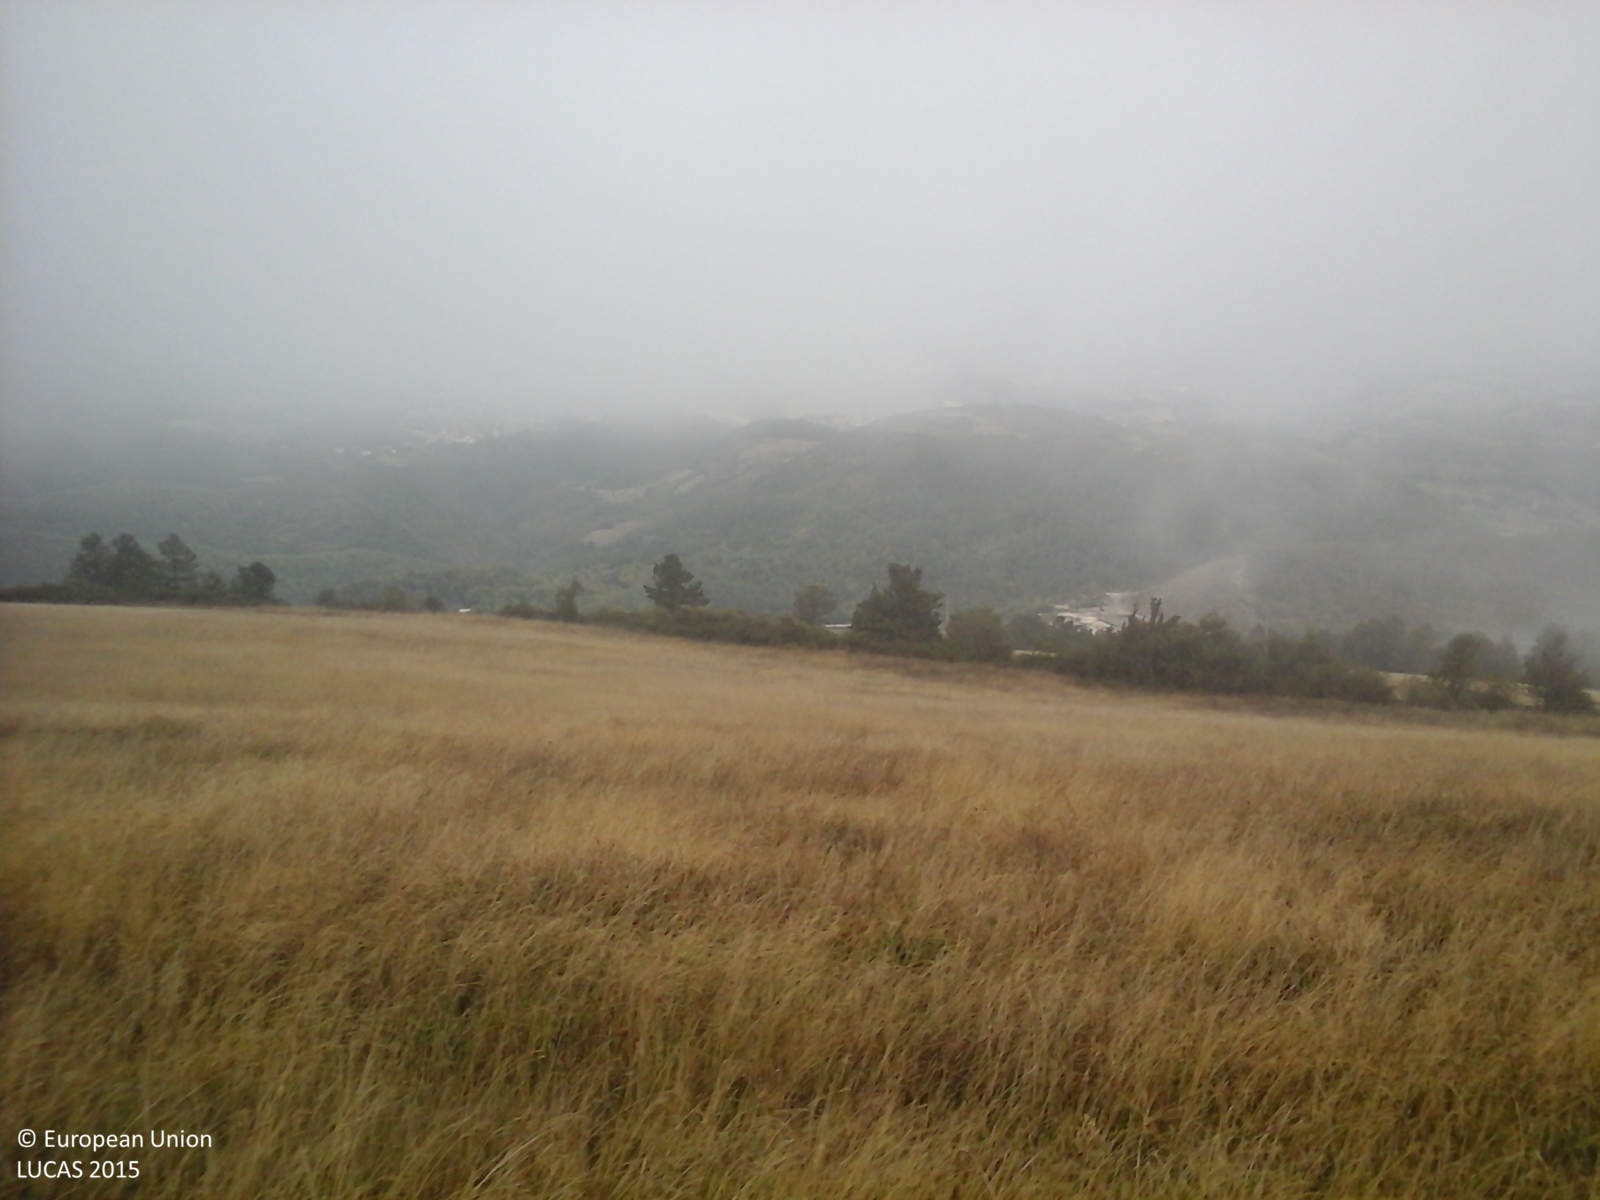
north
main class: Grassland
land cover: Grassland without tree/shrub cover
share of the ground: > 75 %
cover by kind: herbaceous plants 100 %
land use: Agriculture (excluding fallow land and kitchen gardens)
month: September
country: IT
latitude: 43.4408
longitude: 12.9947
